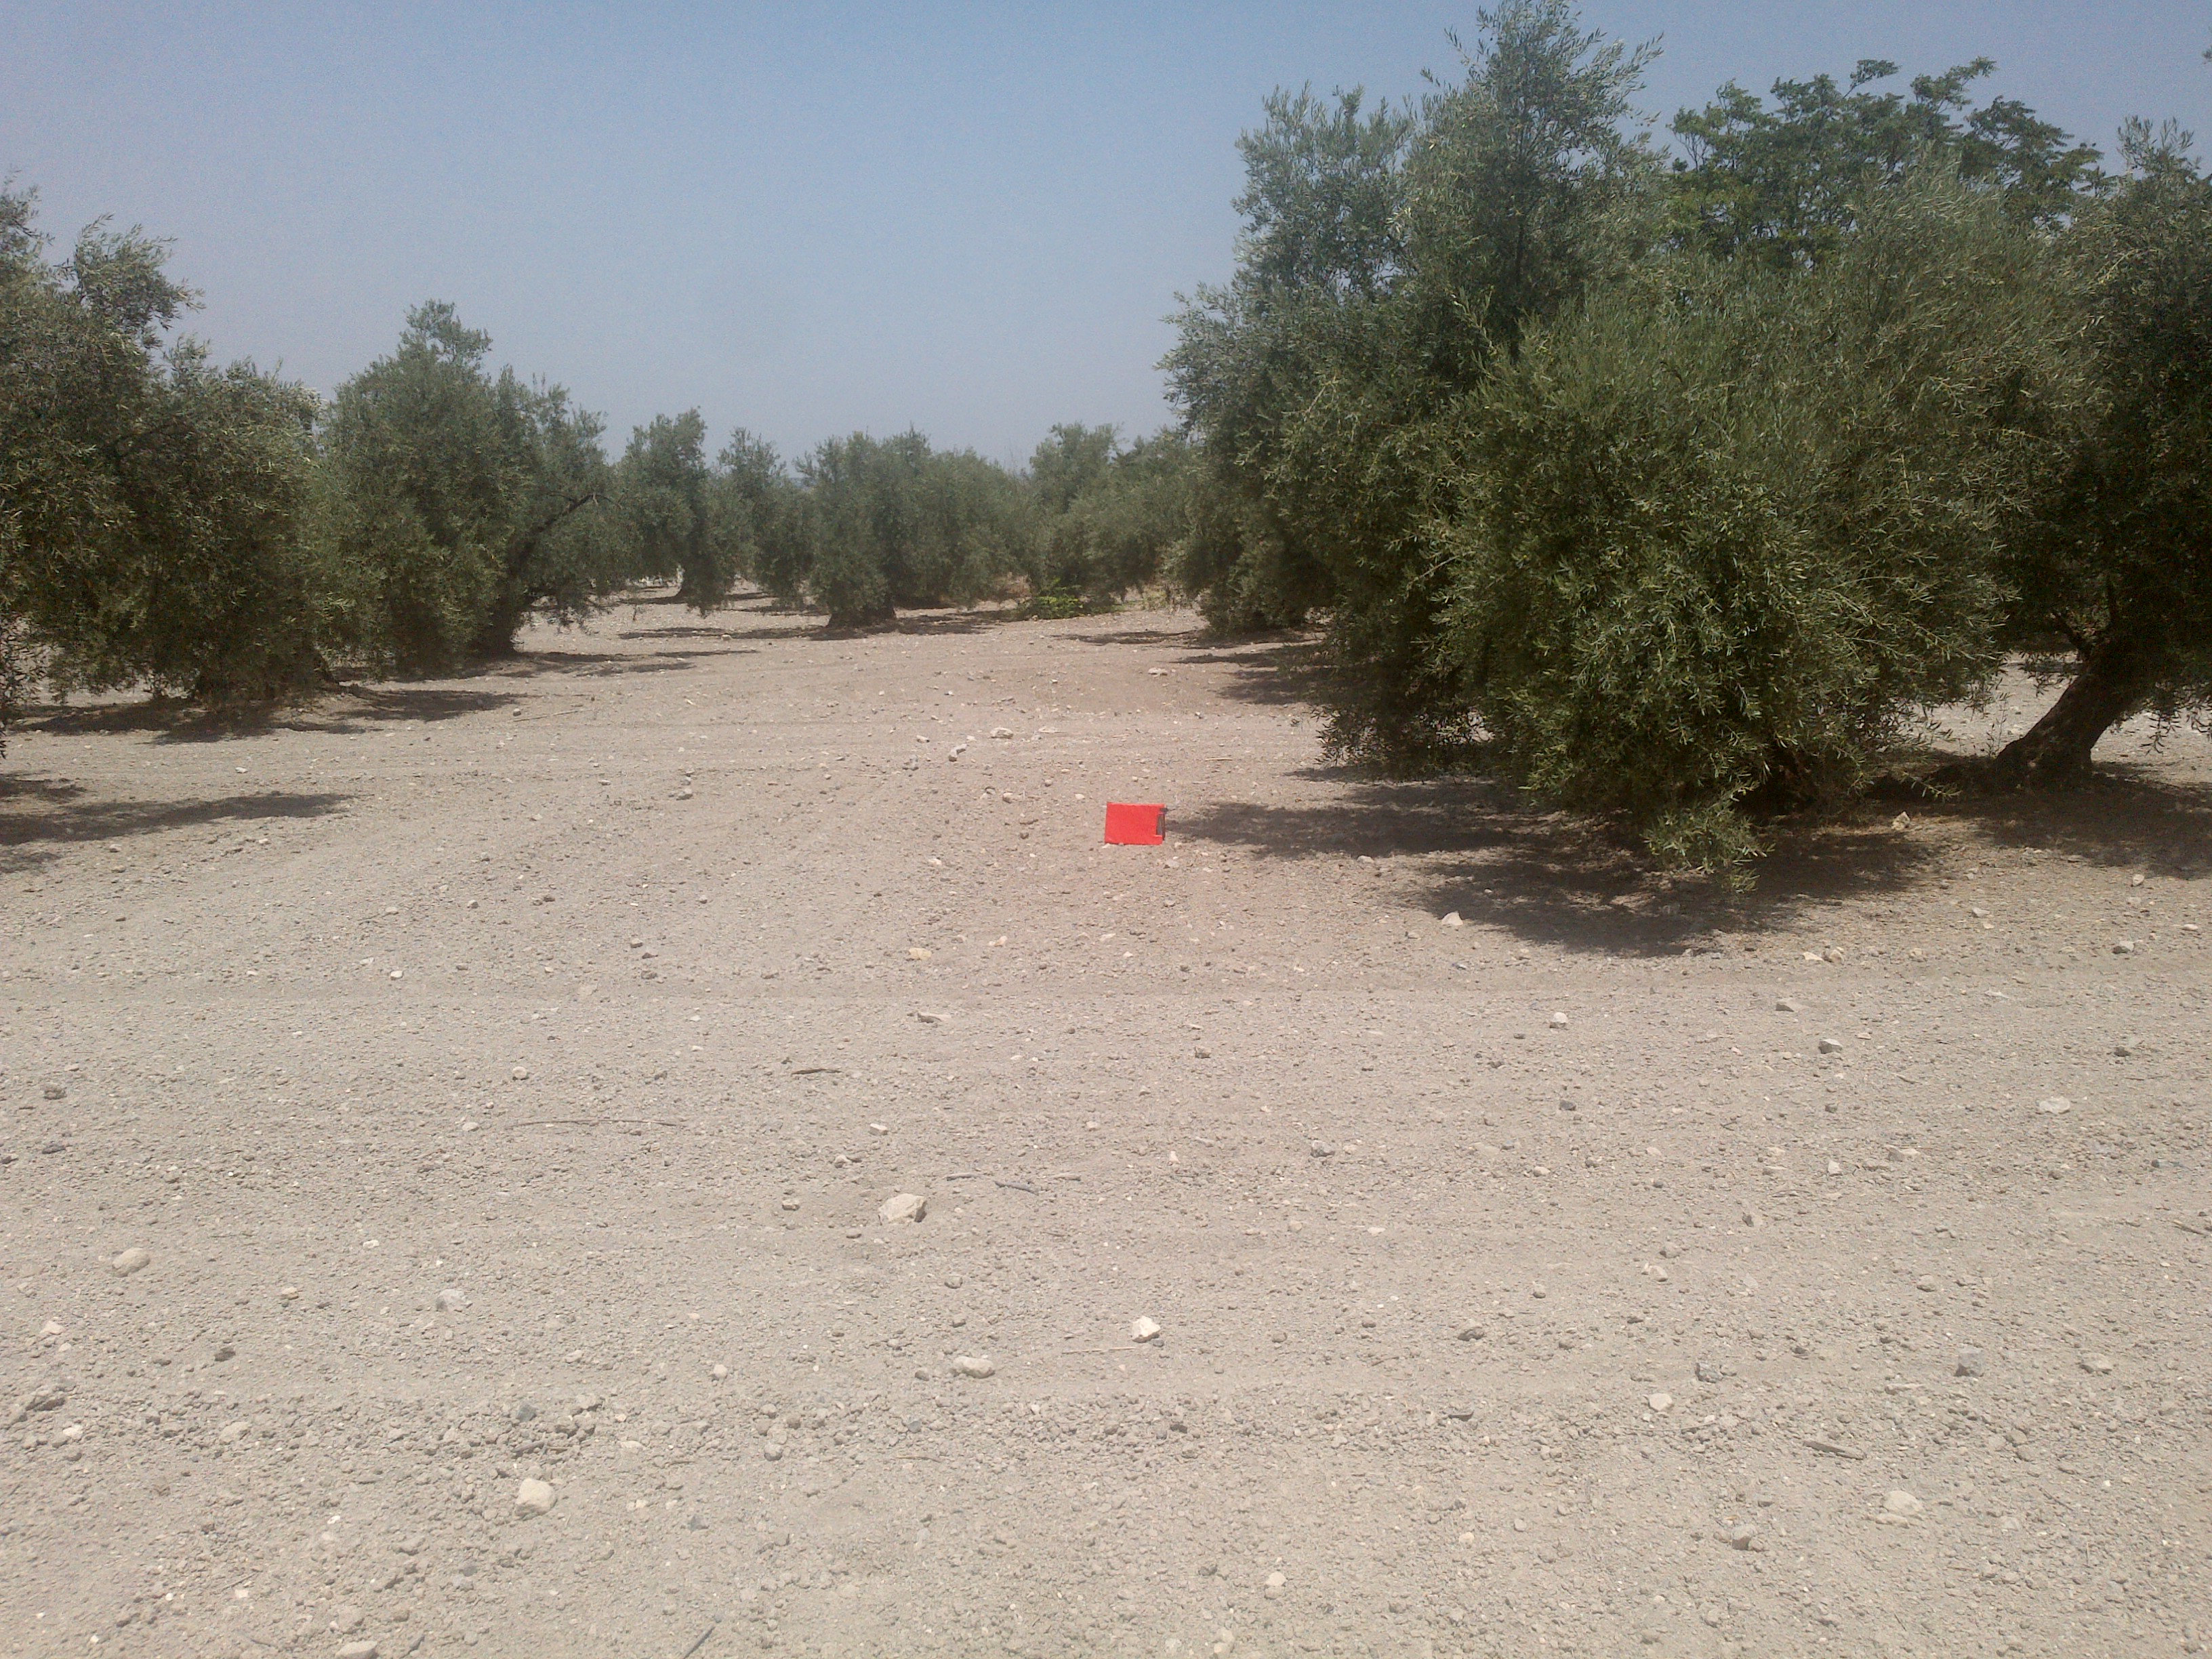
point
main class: Cropland
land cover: Olive groves
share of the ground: 50 - 75 %
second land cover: Other bare soil
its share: > 75 %
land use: Agriculture (excluding fallow land and kitchen gardens)
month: July
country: ES
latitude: 37.4492
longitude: -4.5522
